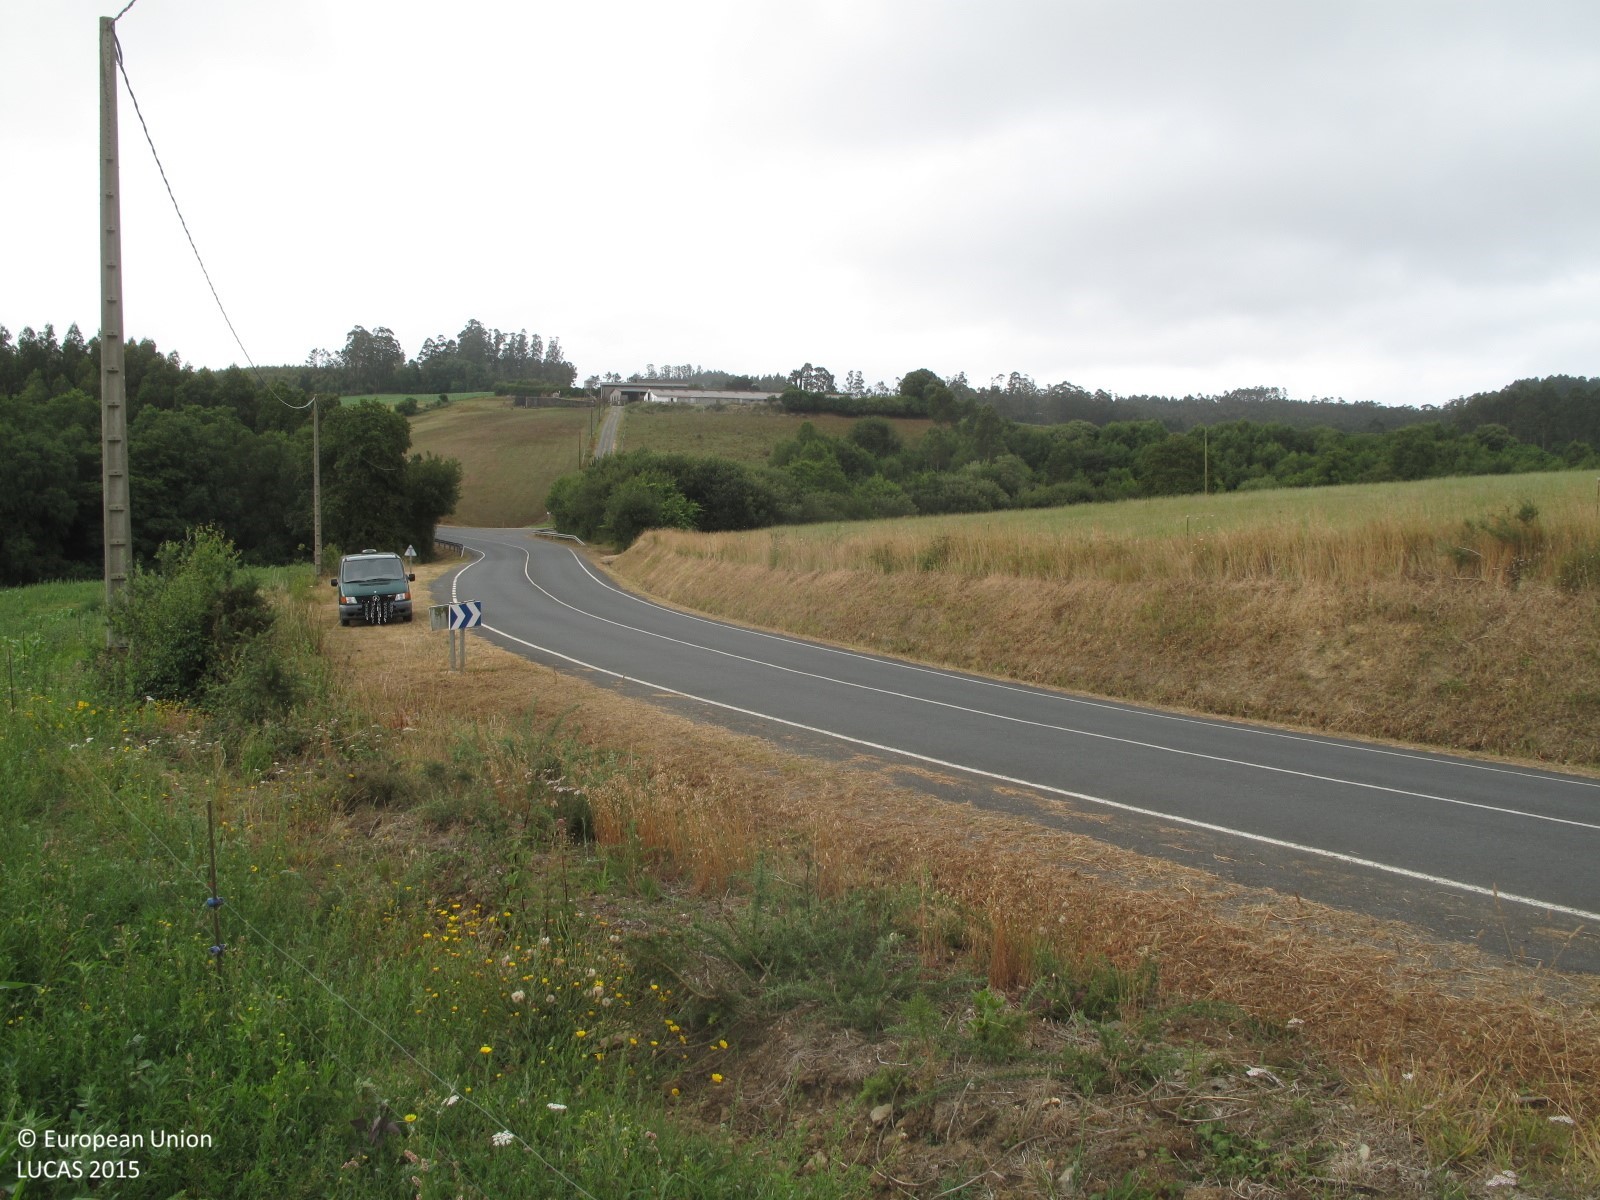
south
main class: Cropland
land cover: Maize
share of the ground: 25 - 50 %
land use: Agriculture (excluding fallow land and kitchen gardens)
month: July
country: ES
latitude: 43.5742
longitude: -8.0918
